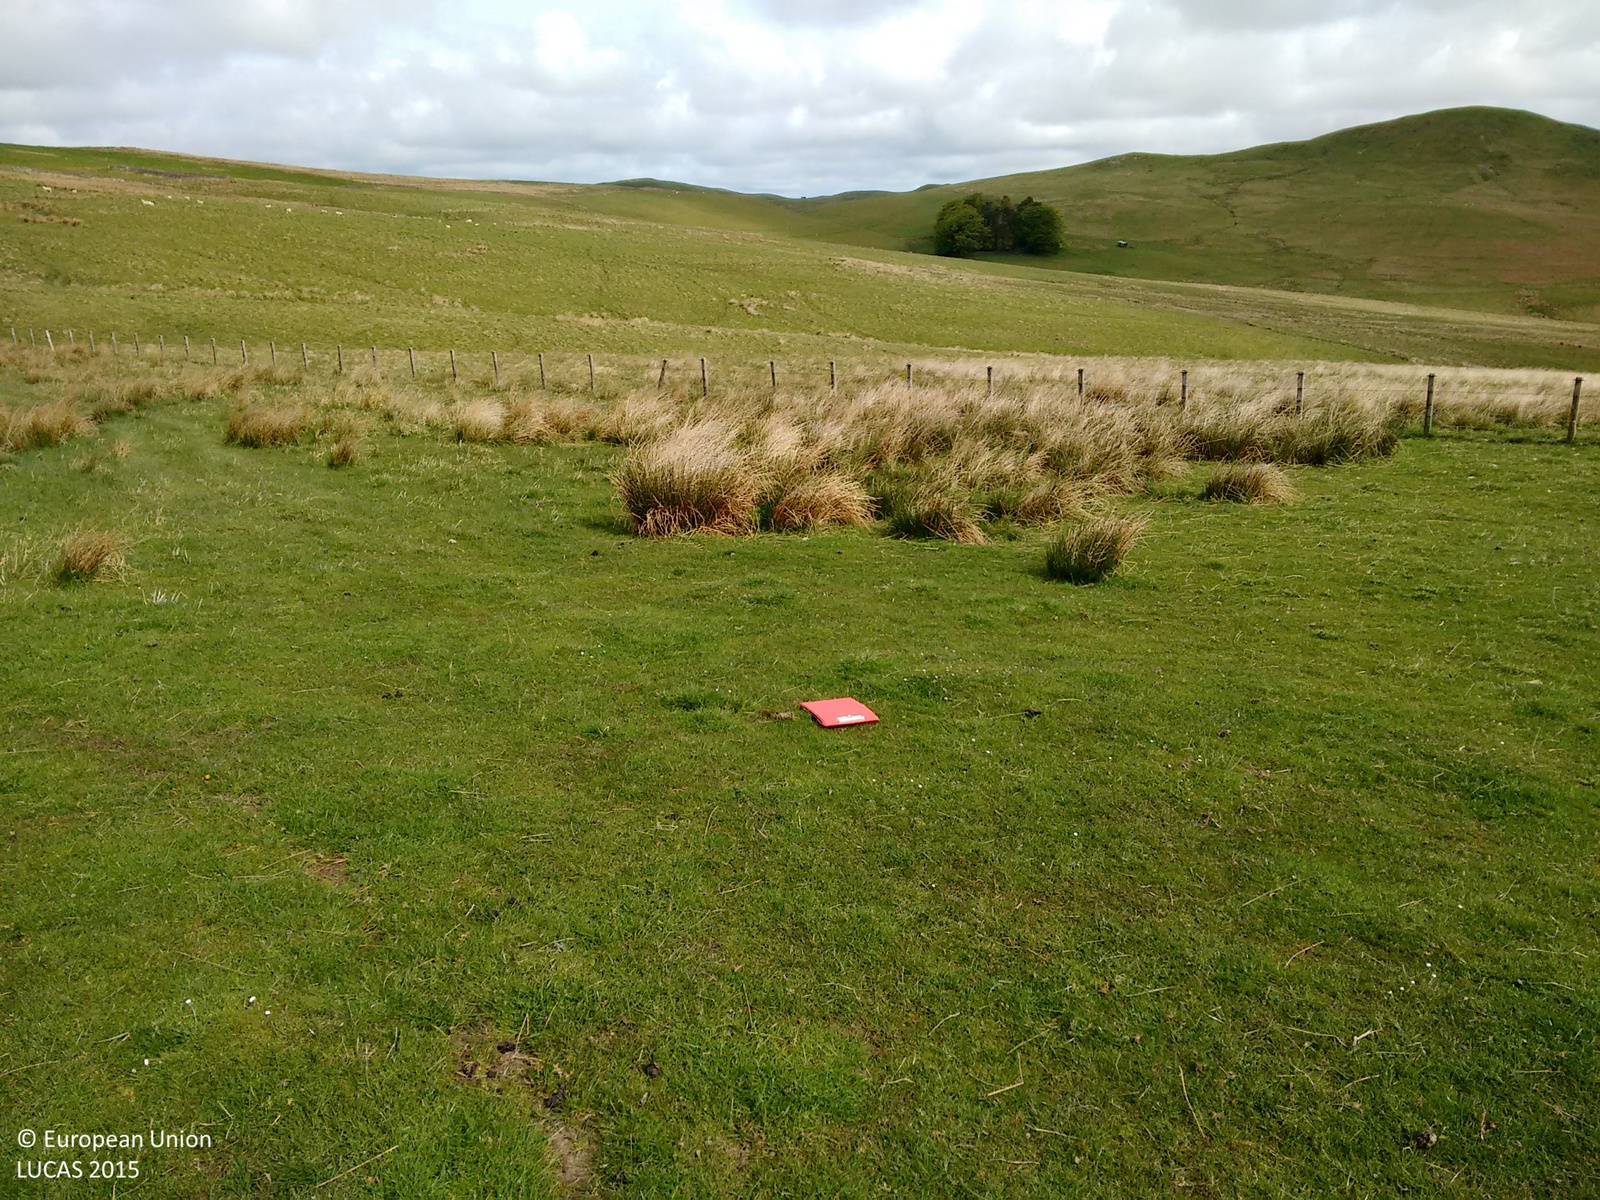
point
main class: Grassland
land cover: Grassland without tree/shrub cover
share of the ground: > 75 %
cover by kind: herbaceous plants 100 %
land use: Agriculture (excluding fallow land and kitchen gardens)
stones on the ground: < 10 %
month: May
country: GB
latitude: 55.3843
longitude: -2.3872
